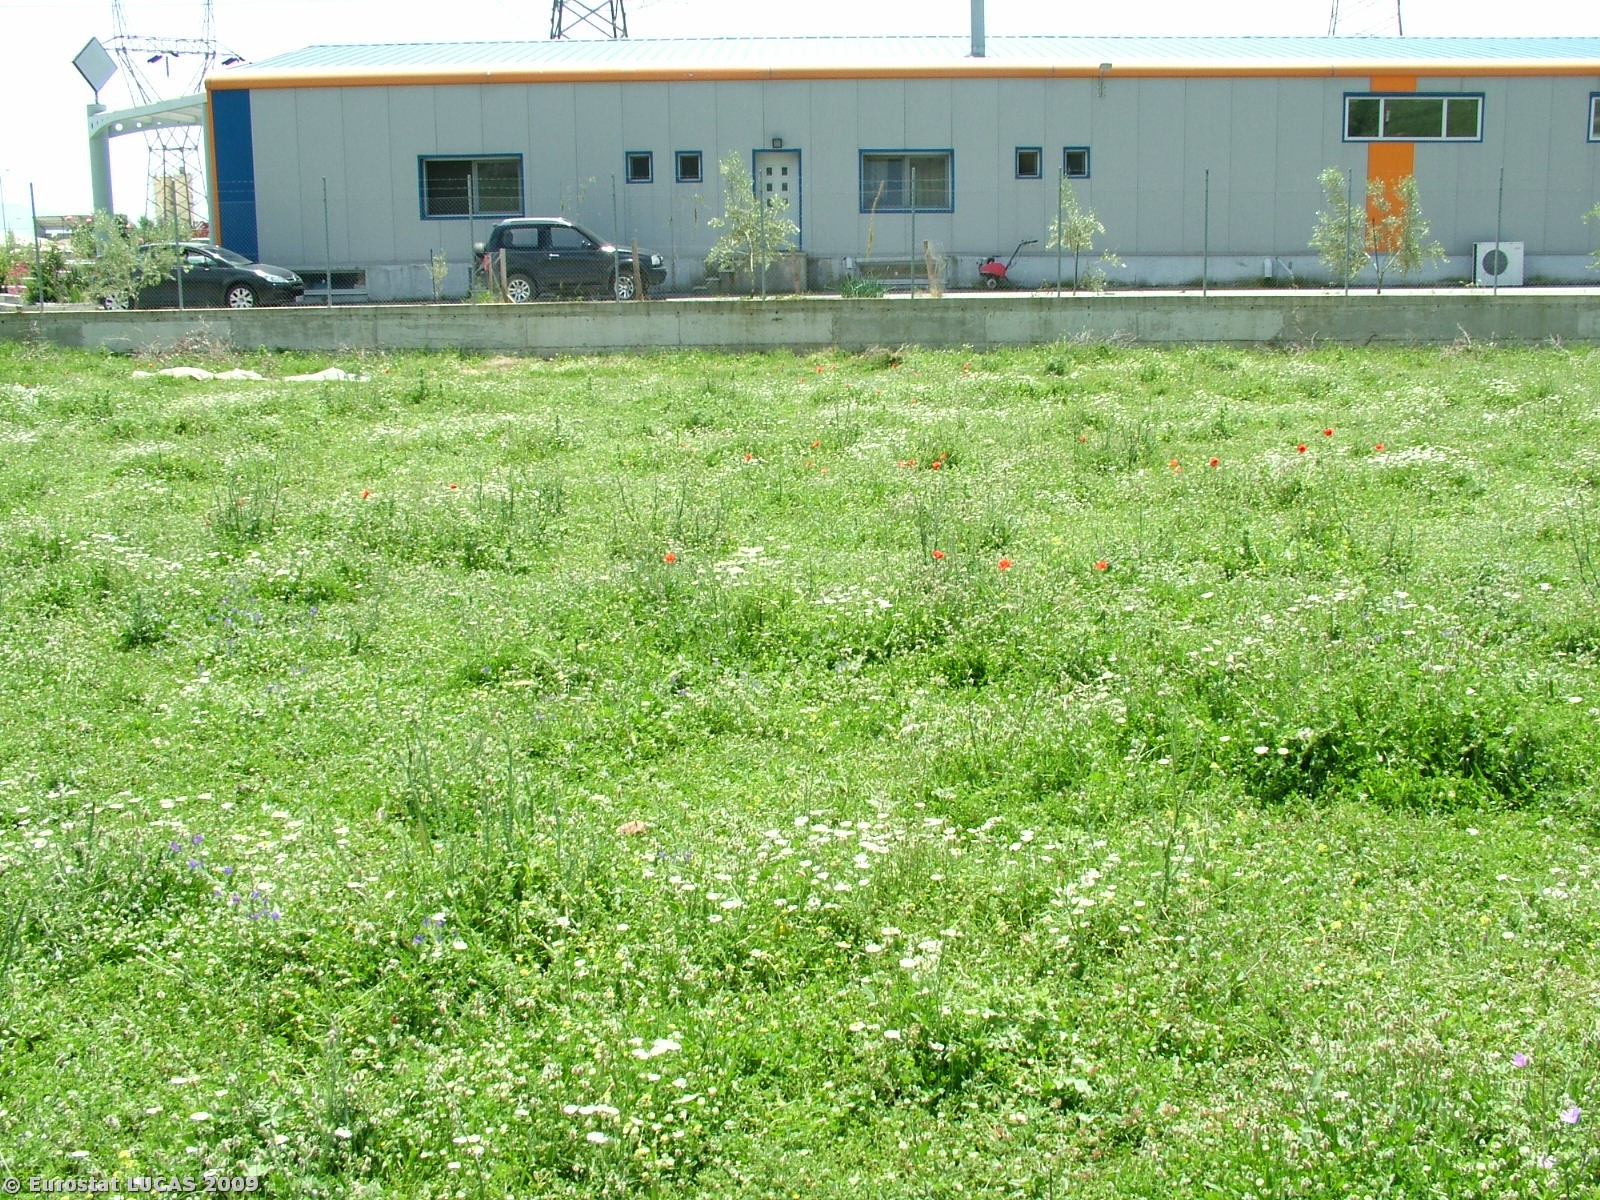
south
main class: Grassland
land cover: Grassland without tree/shrub cover
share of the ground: > 75 %
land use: Agriculture (excluding fallow land and kitchen gardens)
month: May
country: GR
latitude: 40.9674
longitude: 24.4696
